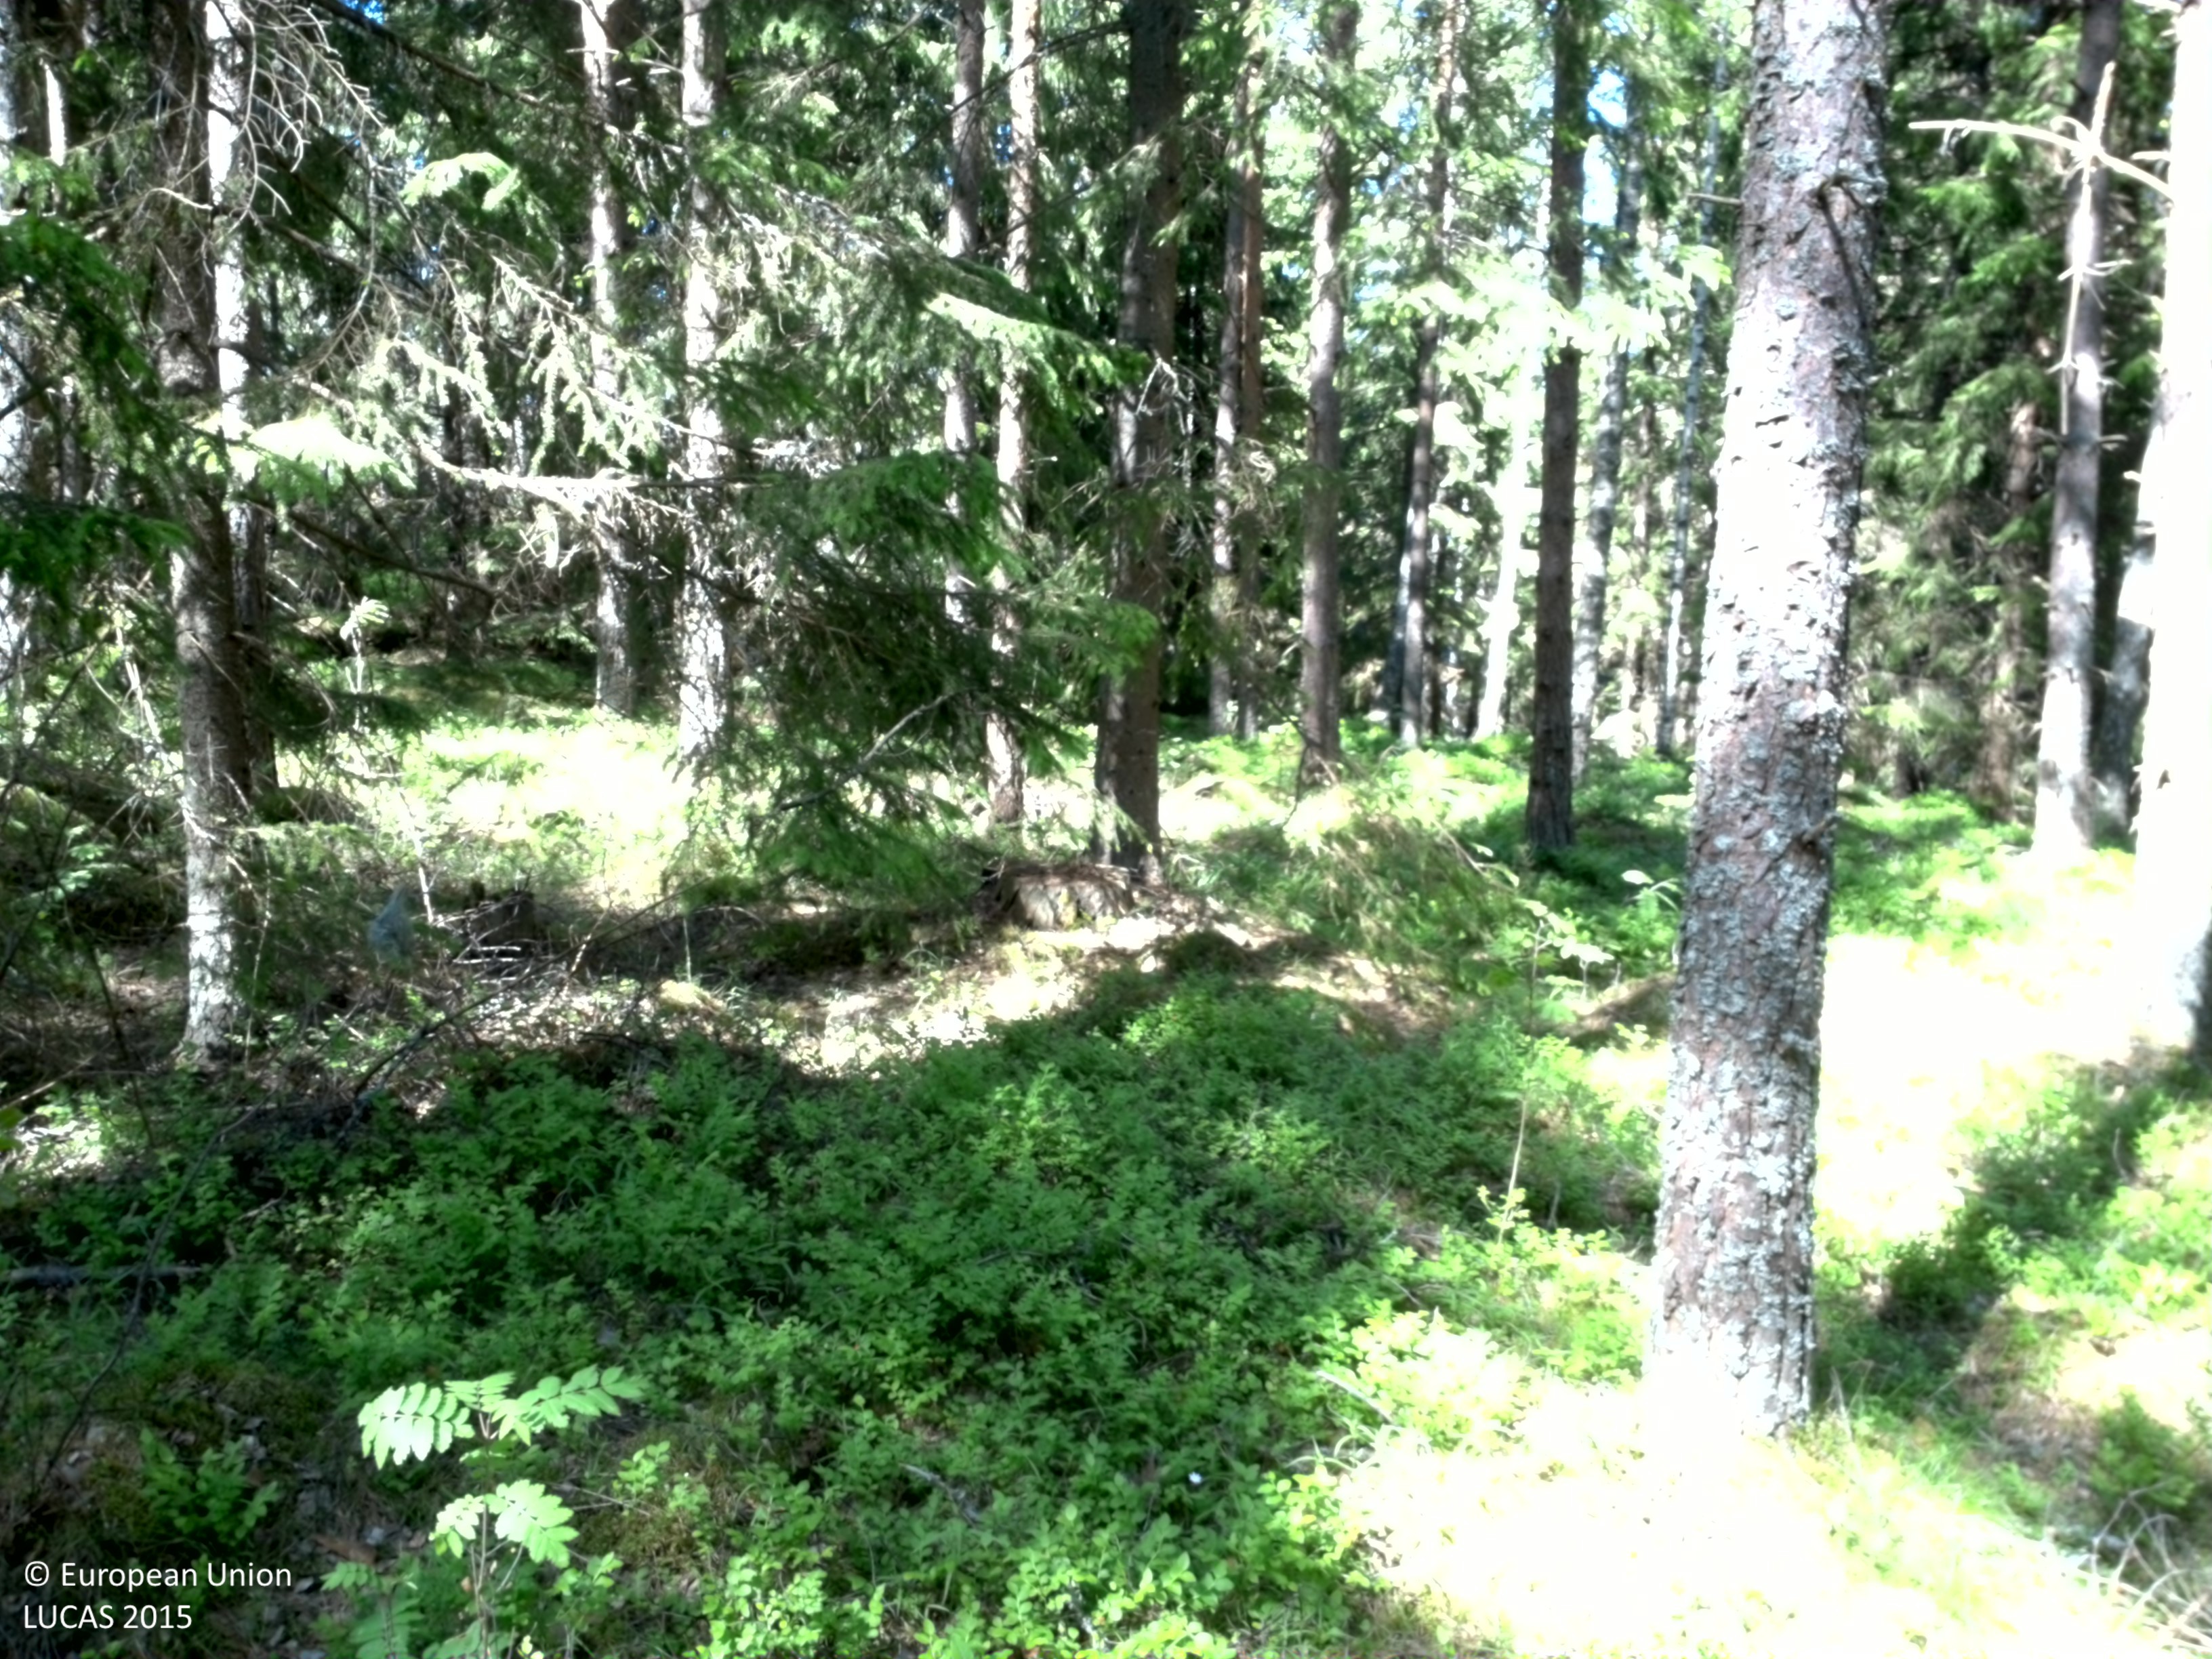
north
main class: Woodland
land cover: Pine dominated coniferous woodland
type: boreal forest
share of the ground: 25 - 50 %
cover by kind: herbaceous plants 45 %, coniferous forest trees 30 %, lichens and mosses 20 %, broadleaved forest trees 5 %
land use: Forestry
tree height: > 5 m
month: June
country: SE
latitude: 58.6958
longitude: 16.4661
